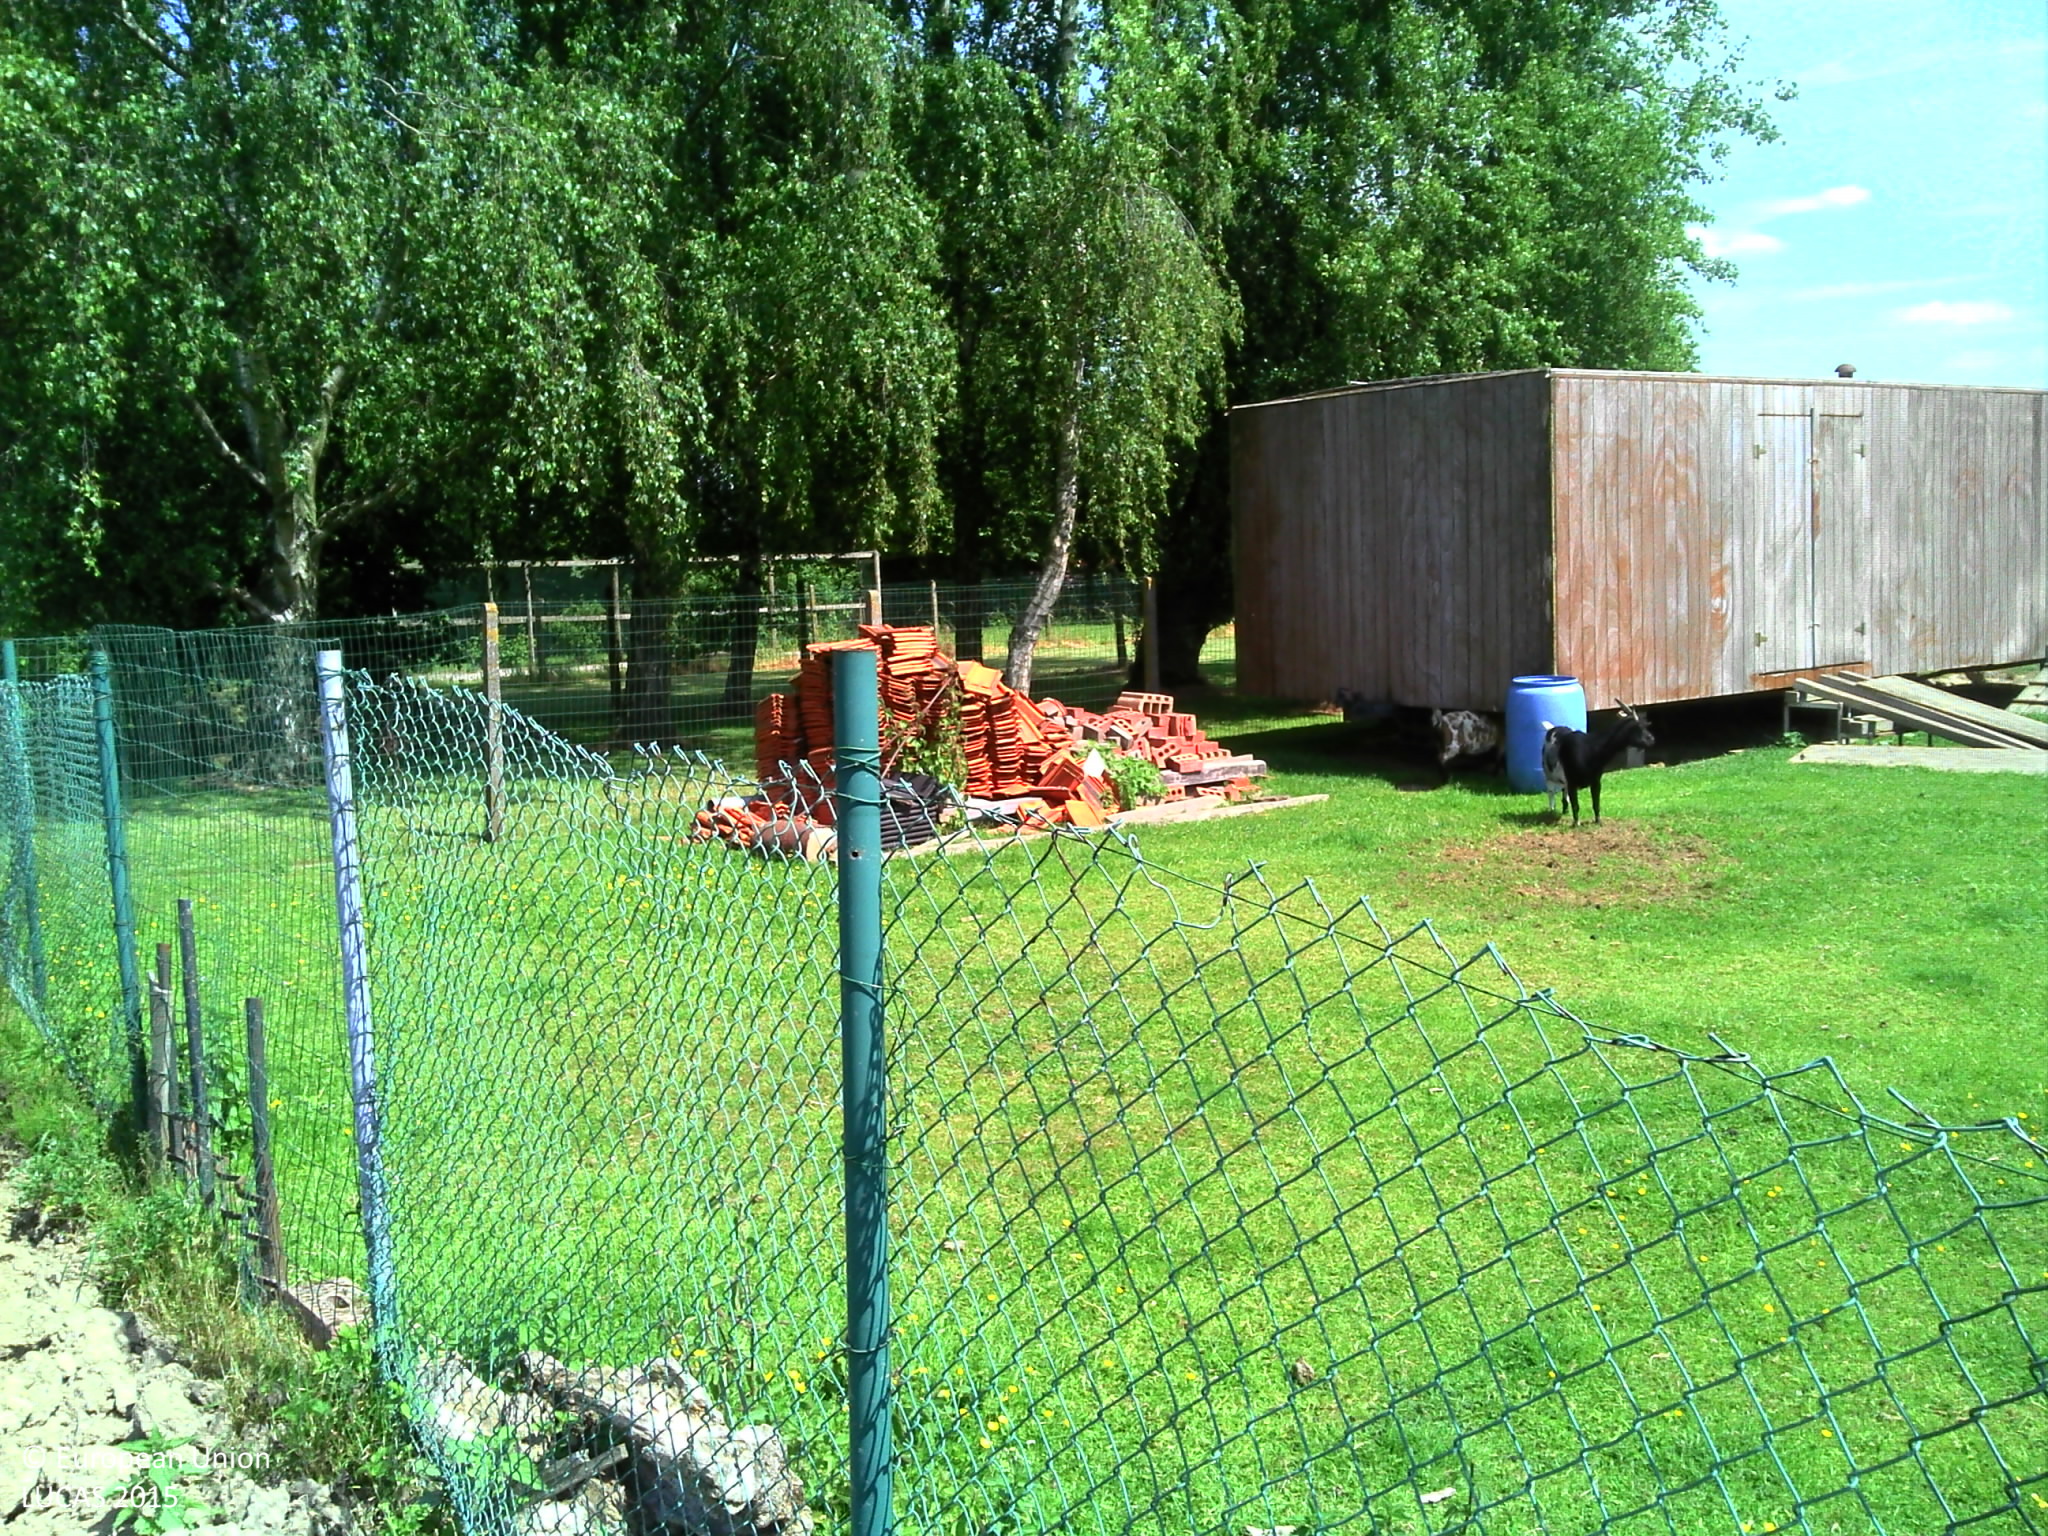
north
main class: Grassland
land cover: Grassland without tree/shrub cover
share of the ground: > 75 %
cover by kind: herbaceous plants 85 %, shrubs 5 %
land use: Residential
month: June
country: BE
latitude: 50.8041
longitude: 3.0798
